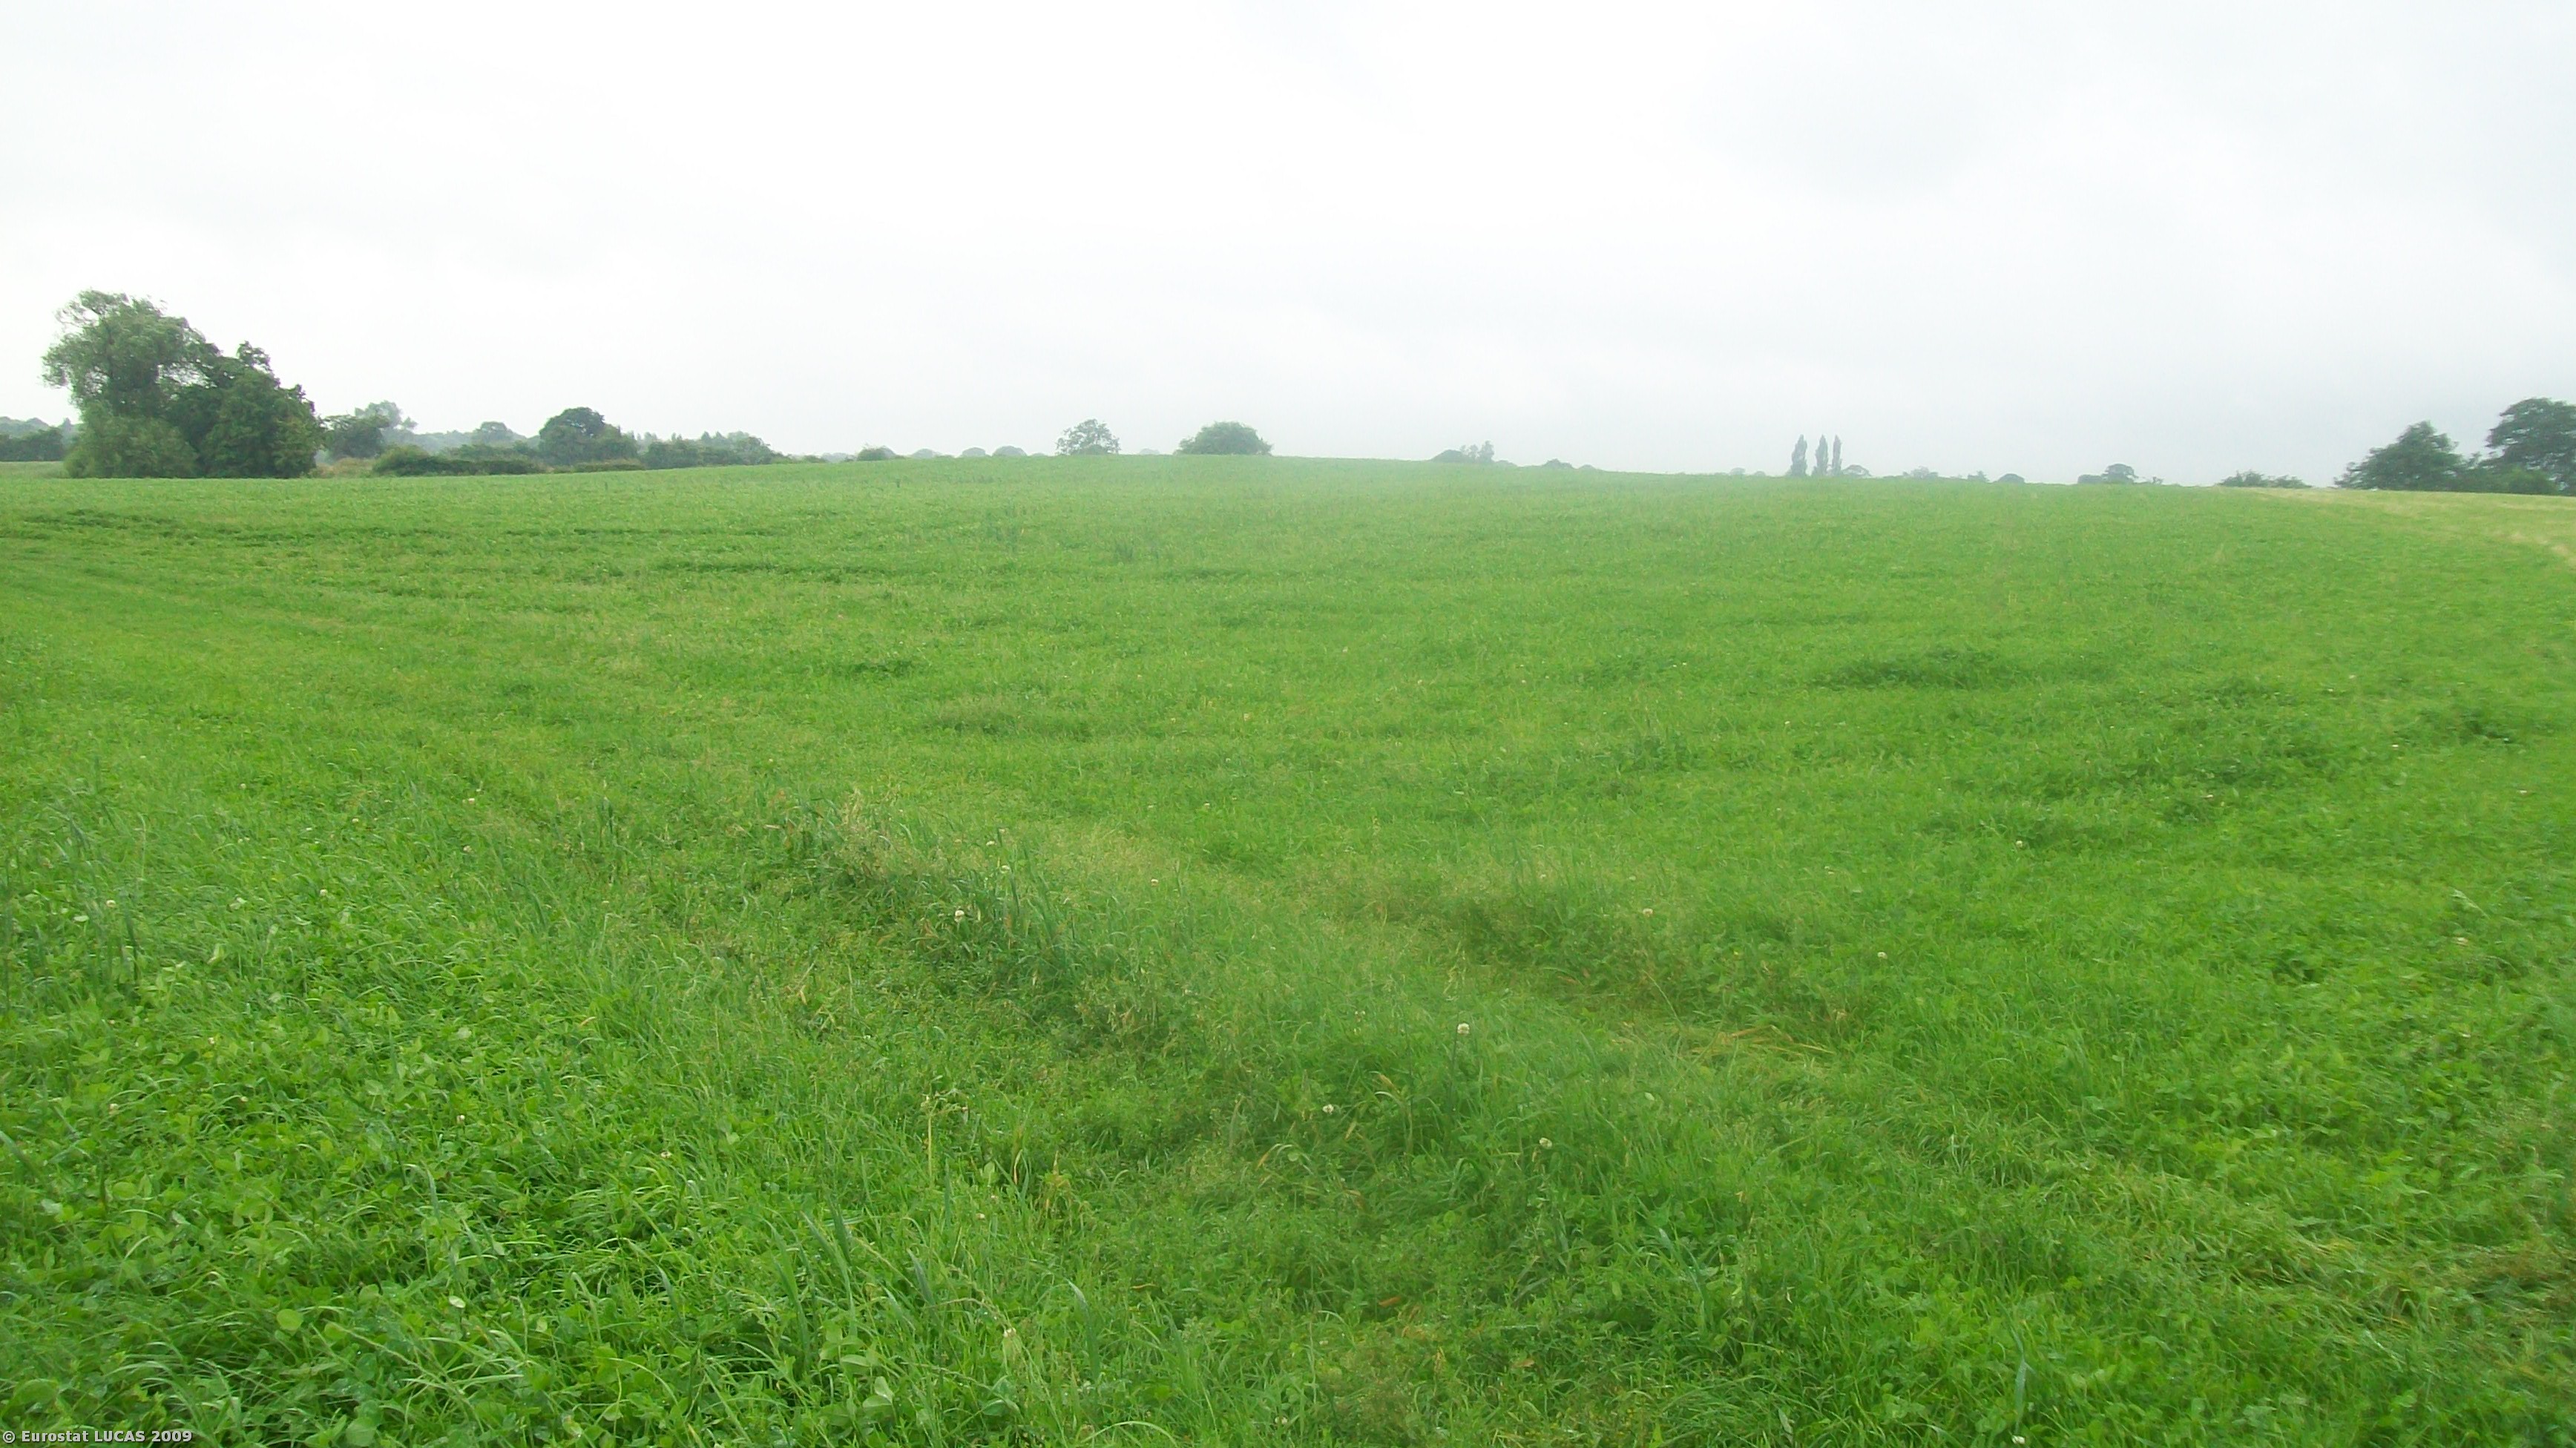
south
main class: Grassland
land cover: Grassland without tree/shrub cover
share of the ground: > 75 %
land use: Agriculture (excluding fallow land and kitchen gardens)
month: July
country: GB
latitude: 52.9333
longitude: -2.6703
